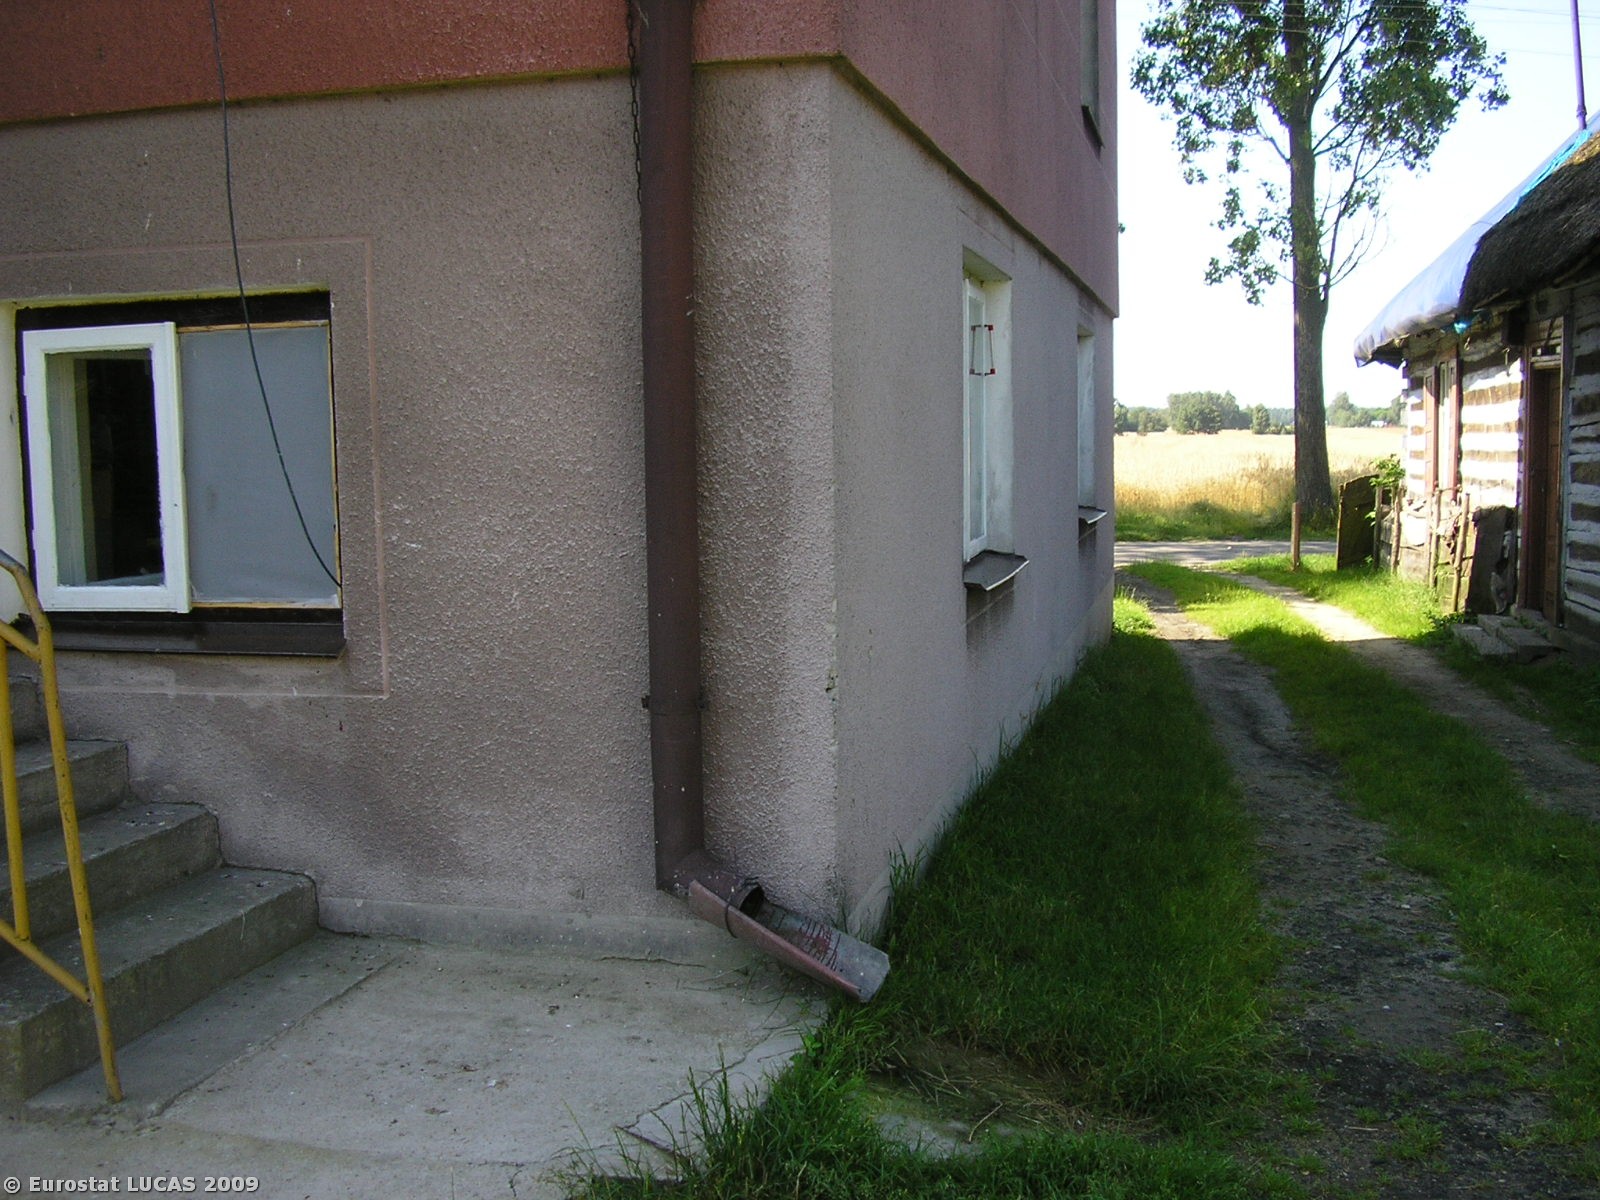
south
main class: Grassland
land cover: Grassland without tree/shrub cover
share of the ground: > 75 %
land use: Residential
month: July
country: PL
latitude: 51.9181
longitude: 22.1133
